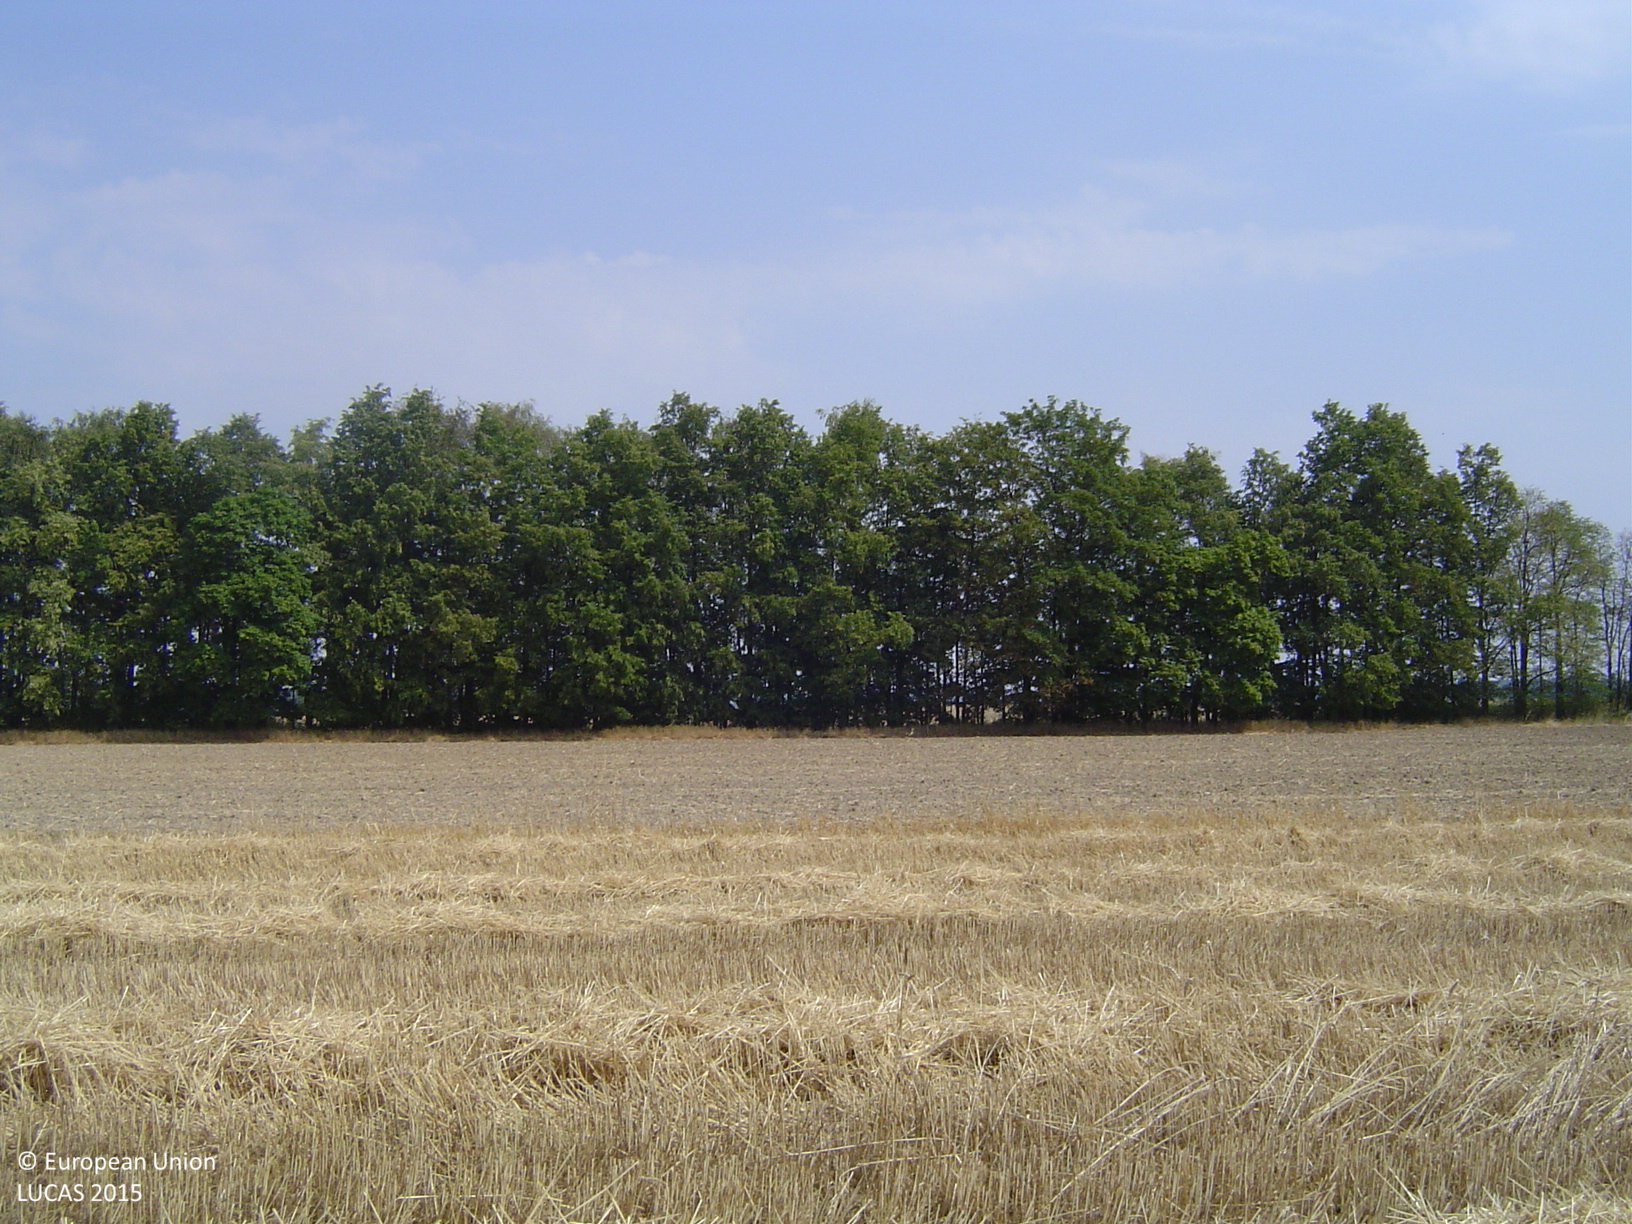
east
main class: Cropland
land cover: Common wheat
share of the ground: > 75 %
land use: Agriculture (excluding fallow land and kitchen gardens)
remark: Harvested field
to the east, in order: Common wheat; Rape and turnip rape; Grass margins; Broadleaved woodland; Shruby margins; Tracks; Common wheat
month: August
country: CZ
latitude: 50.1086
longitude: 14.1540
